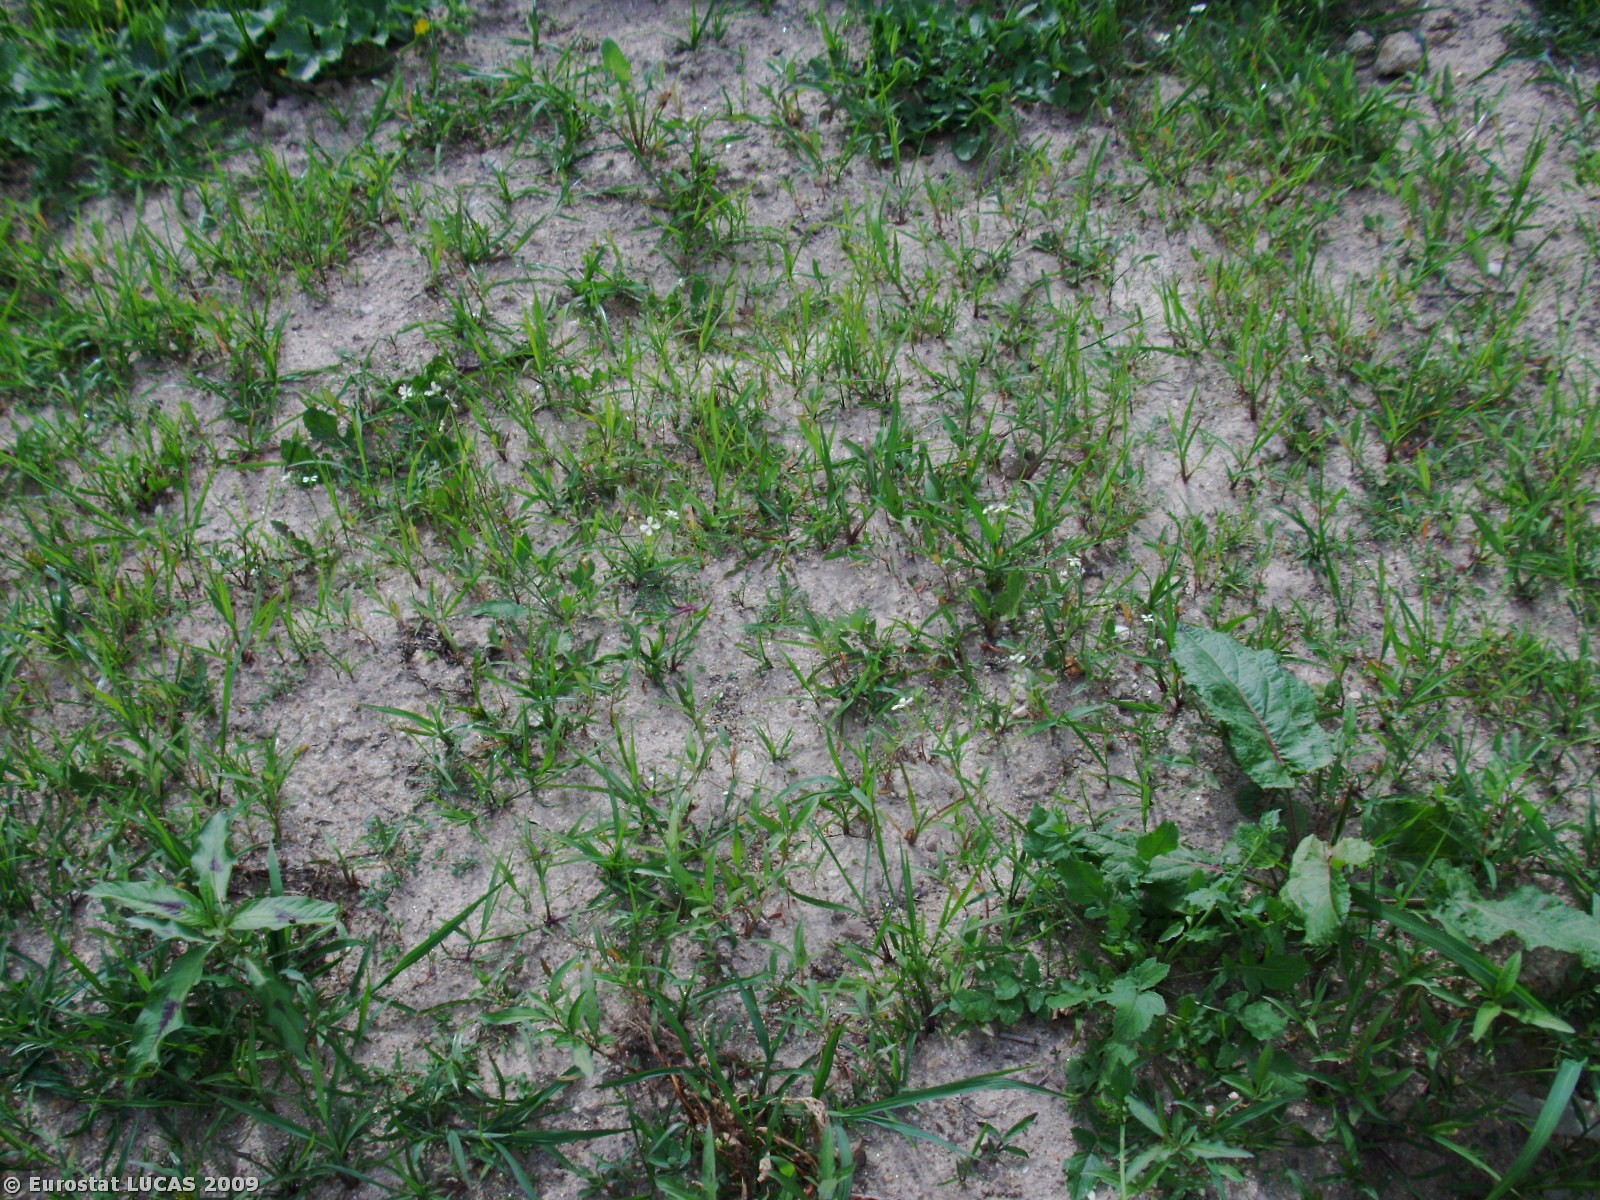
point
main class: Cropland
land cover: Other fresh vegetables
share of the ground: 50 - 75 %
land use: Agriculture (excluding fallow land and kitchen gardens)
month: June
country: PT
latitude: 41.2038
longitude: -8.6263
